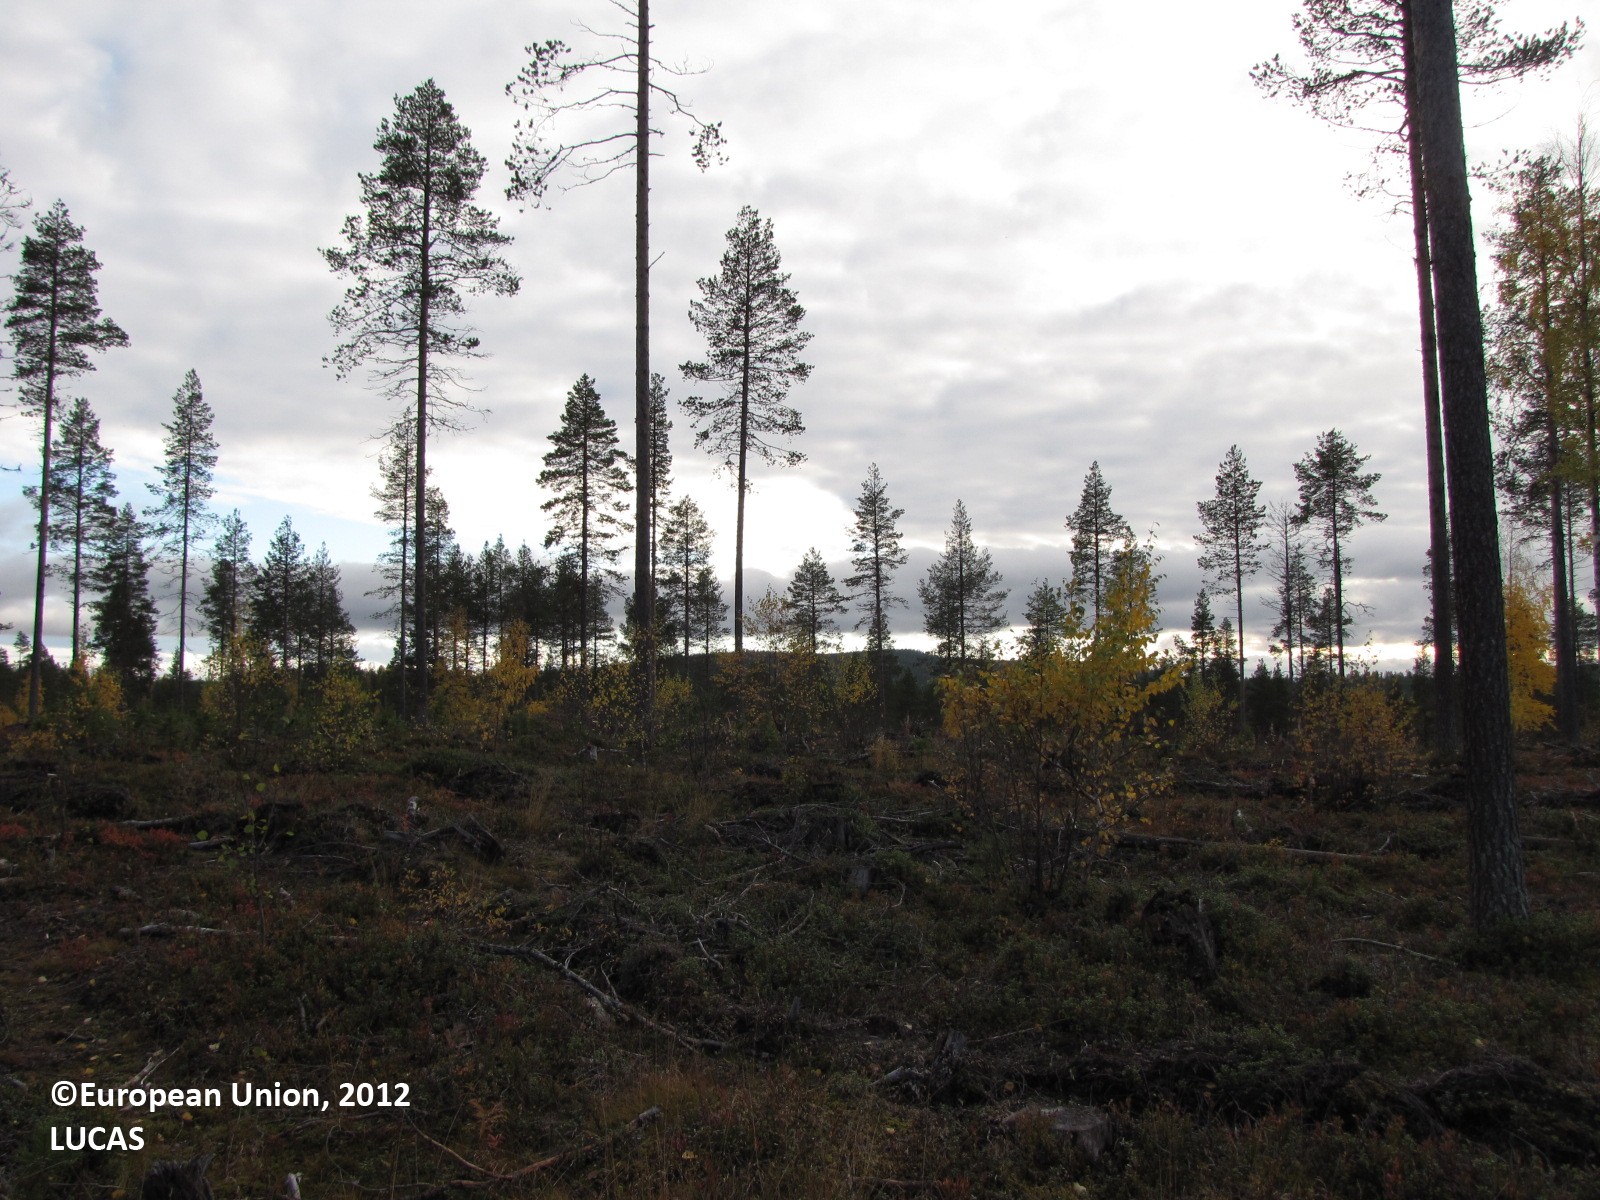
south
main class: Grassland
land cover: Grassland with sparse tree/shrub cover
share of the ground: 10 - 25 %
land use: Forestry
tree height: < 5 m
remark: Clear cut
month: September
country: FI
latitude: 67.4458
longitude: 23.7340
